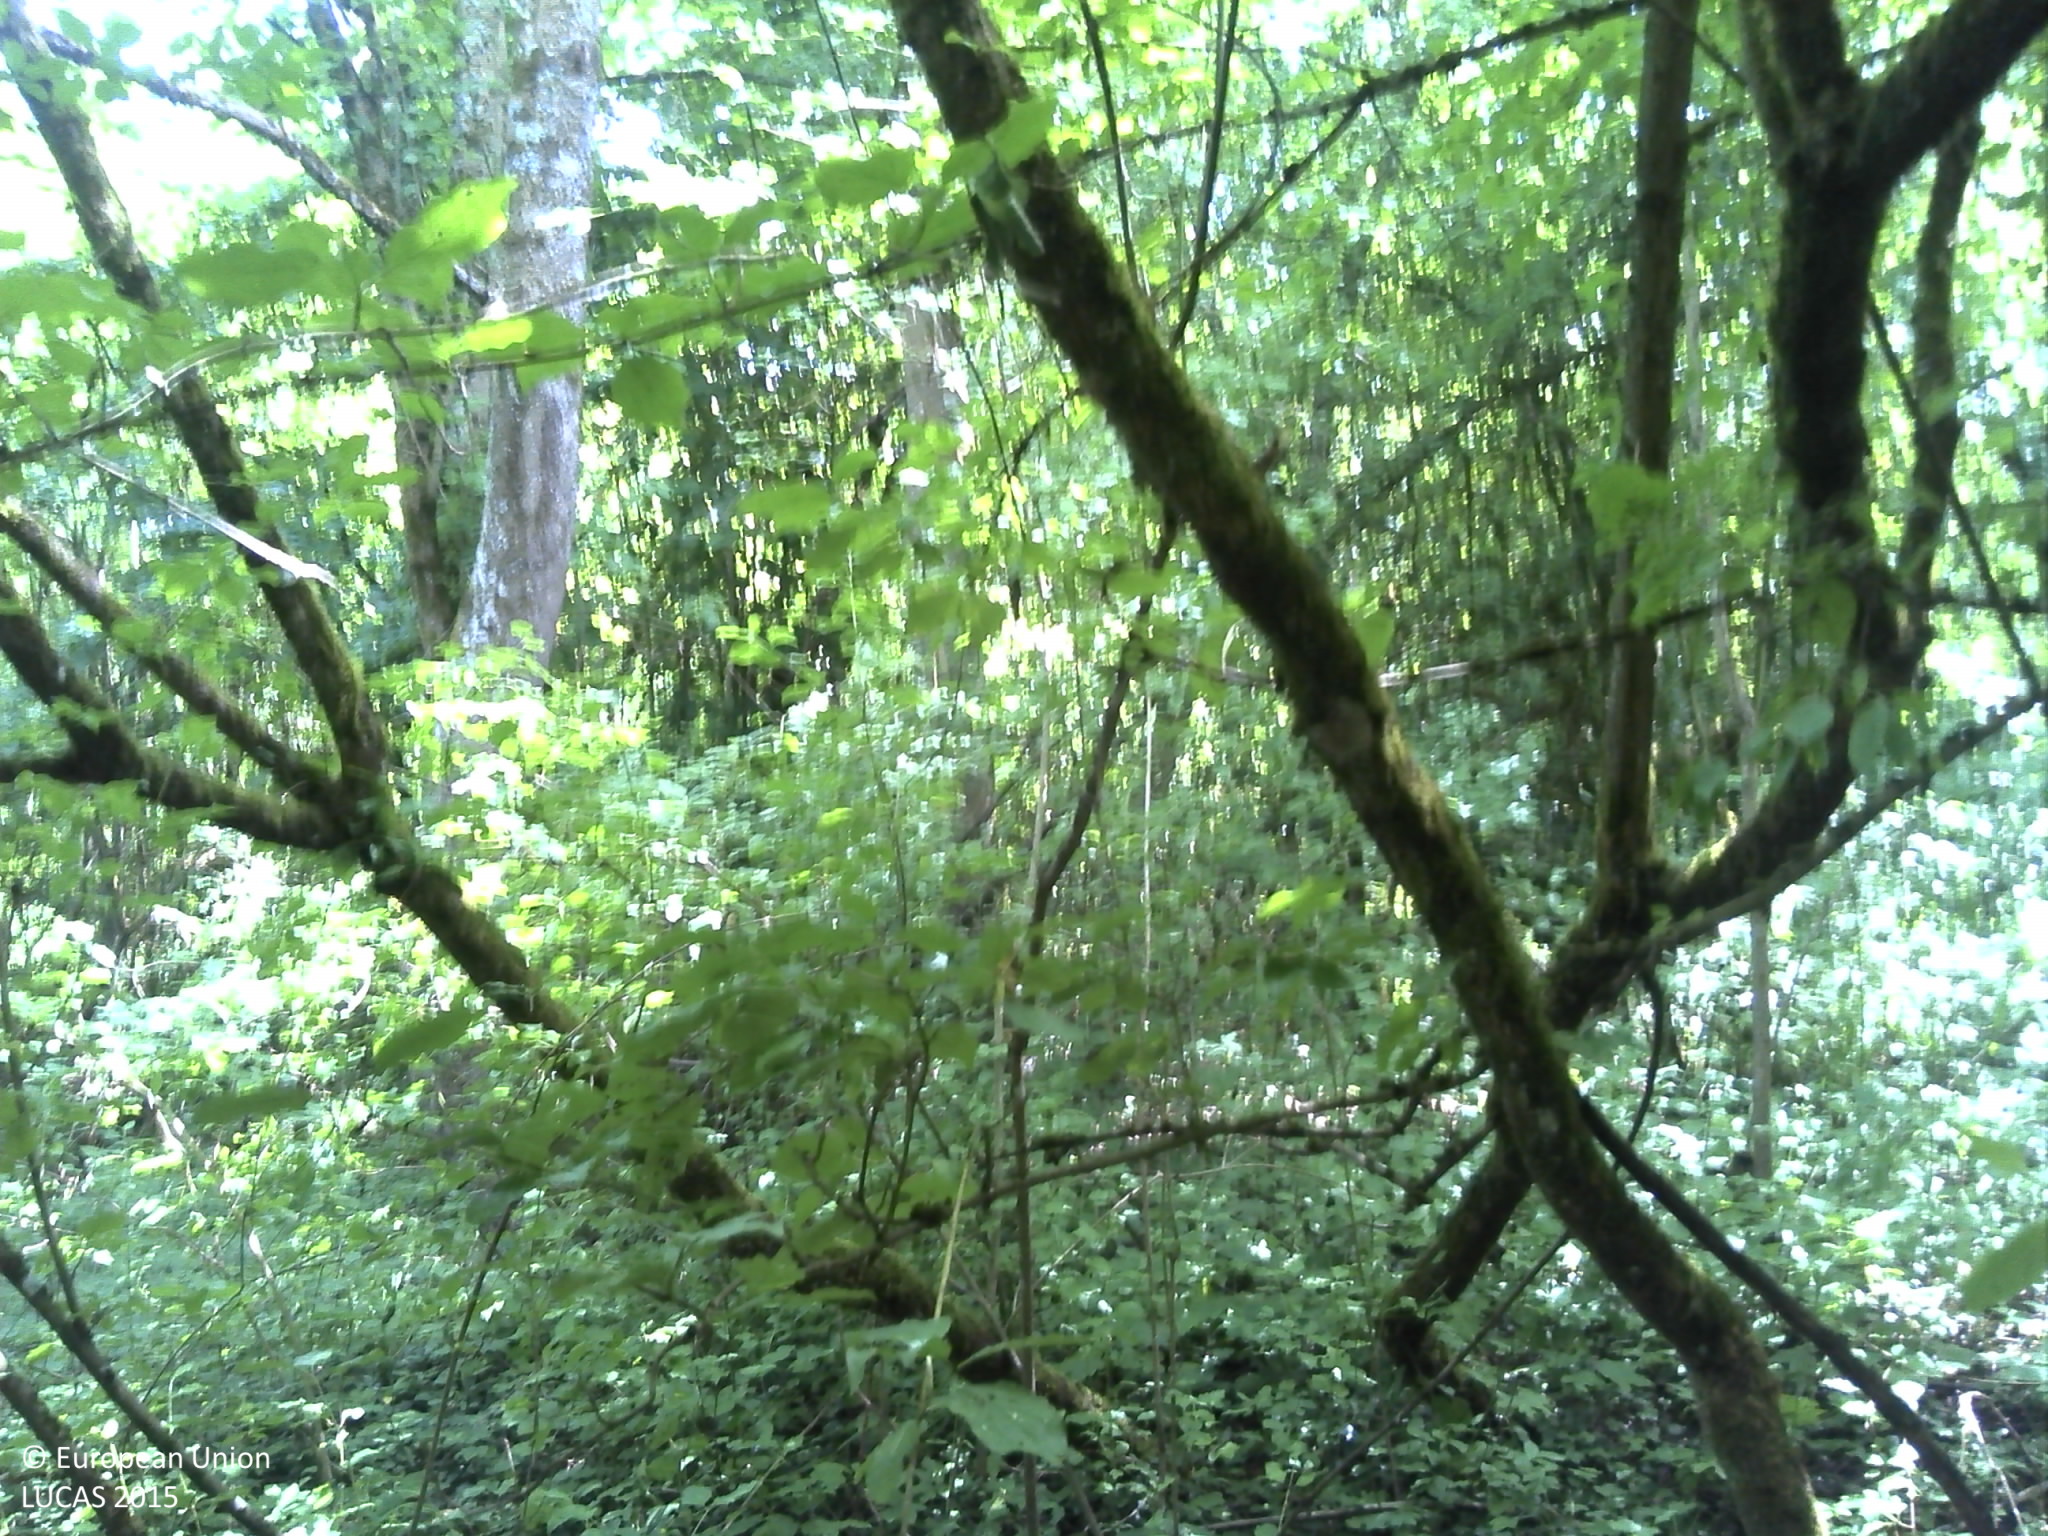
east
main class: Woodland
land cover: Broadleaved woodland
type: non-riverine alder, birch or aspen forest
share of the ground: > 75 %
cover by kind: broadleaved forest trees 90 %, shrubs 10 %
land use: Semi-natural and natural areas not in use
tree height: > 5 m
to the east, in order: Broadleaved woodland; Fences; Broadleaved woodland; Fences; Broadleaved woodland; Artificial constructions in urban areas; Broadleaved woodland
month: June
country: FR
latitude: 49.2527
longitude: 6.0840
